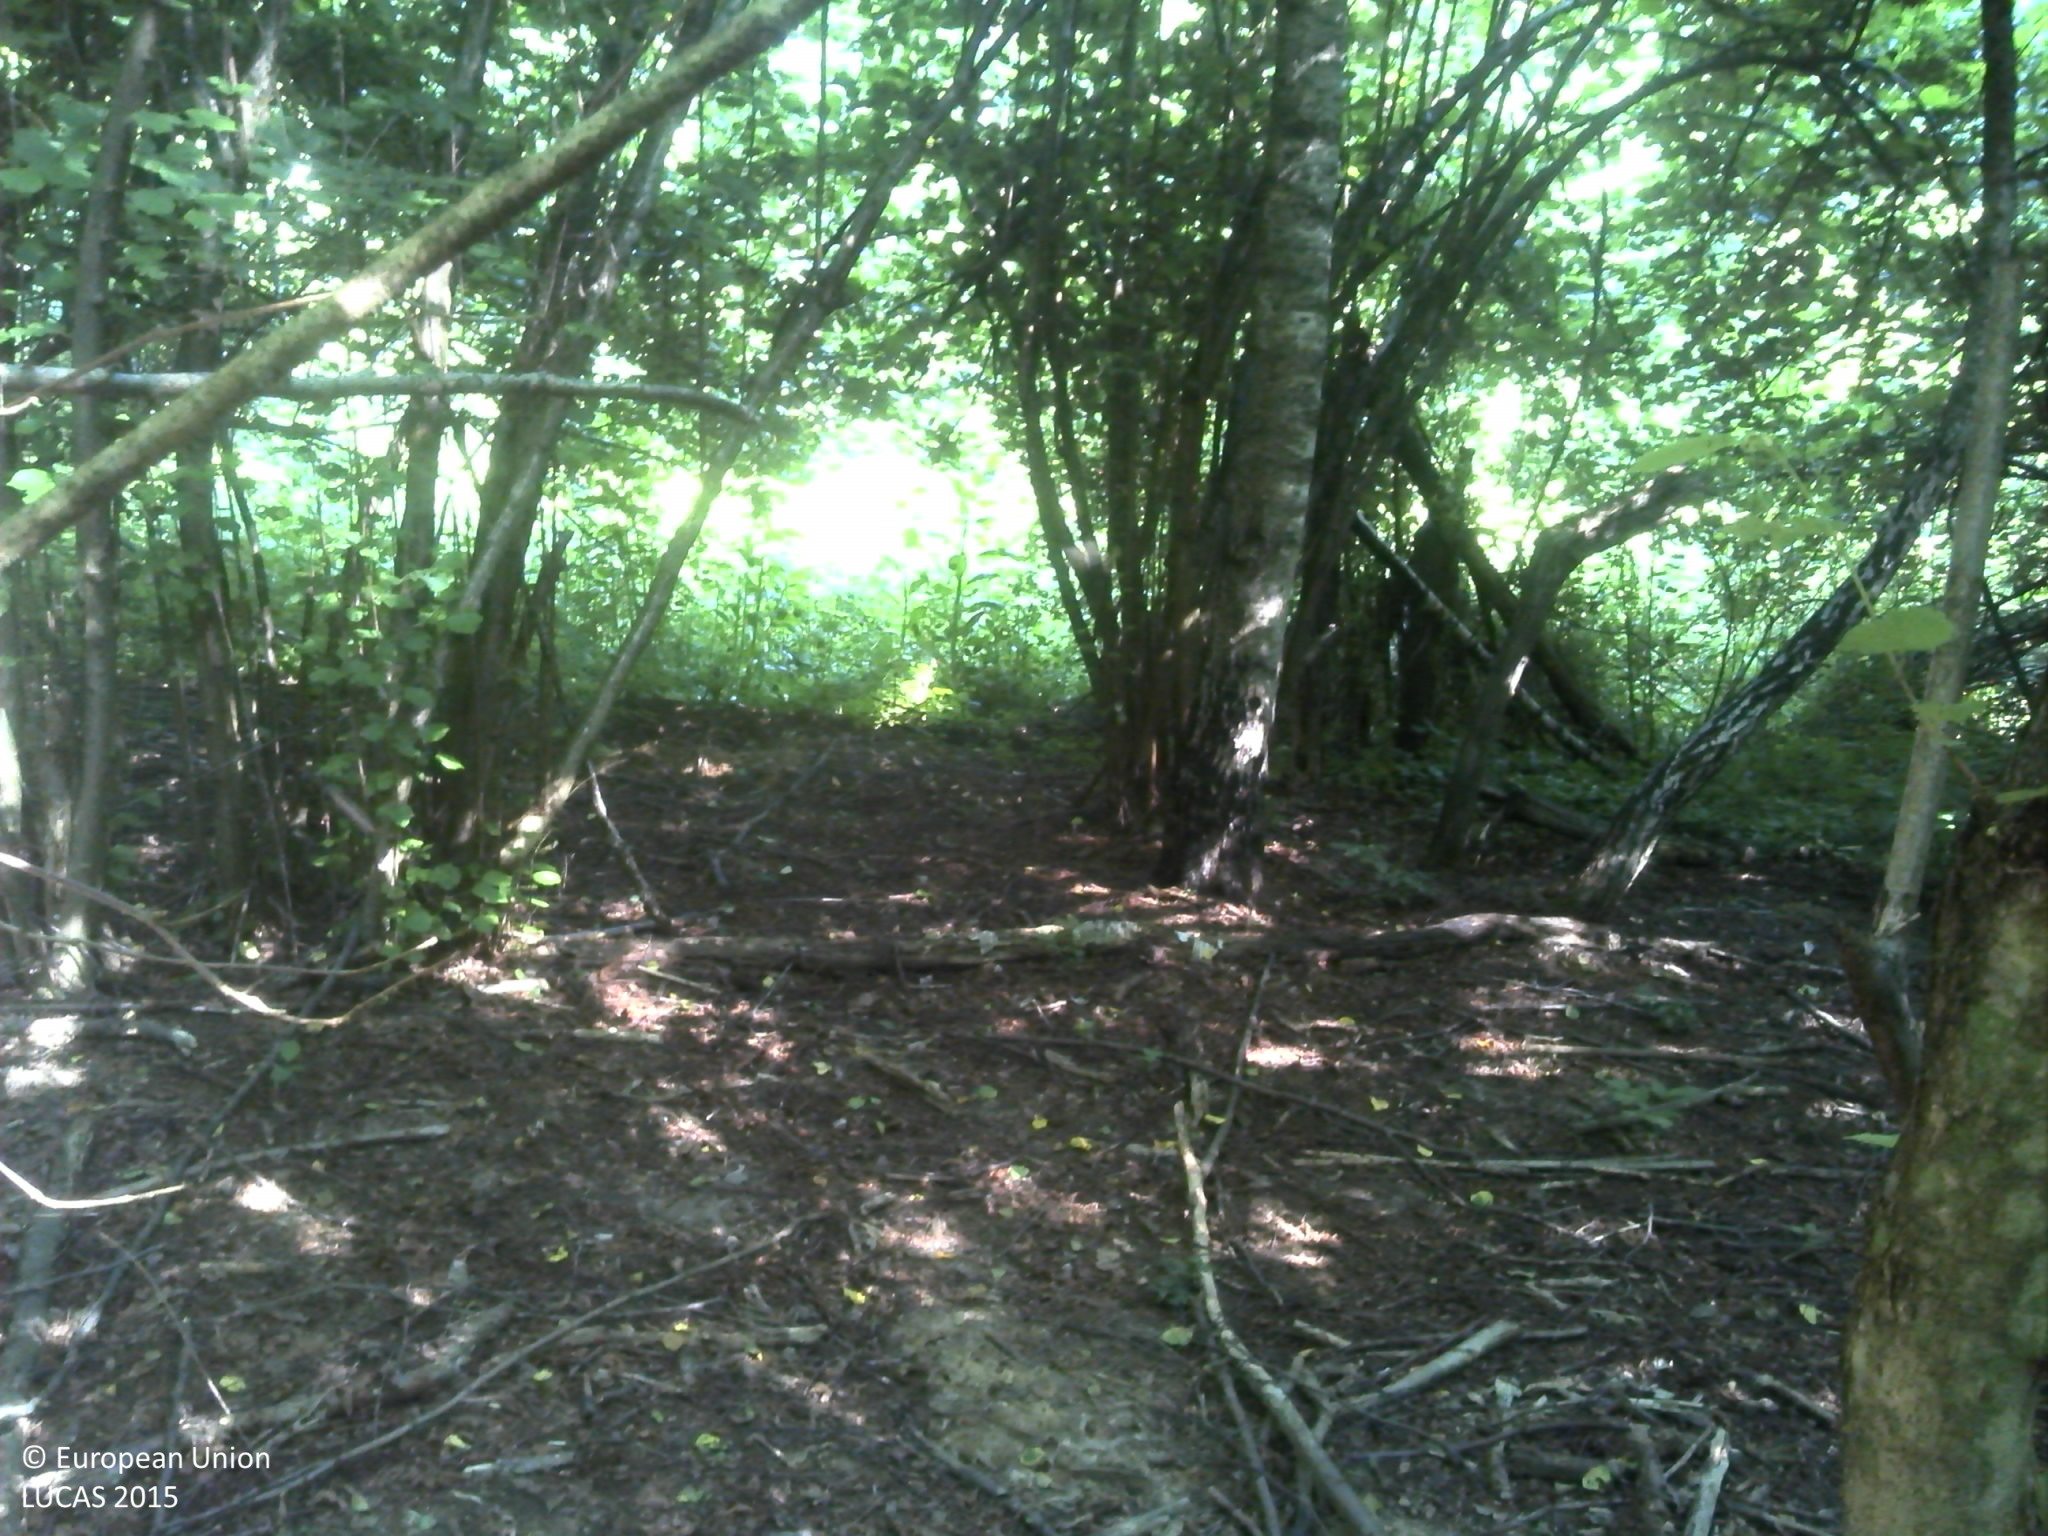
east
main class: Woodland
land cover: Broadleaved woodland
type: acidophilous oak and oak-birch forest
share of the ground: > 75 %
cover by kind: broadleaved forest trees 90 %, shrubs 5 %, herbaceous plants 5 %
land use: Forestry
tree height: > 5 m
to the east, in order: Broadleaved woodland
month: June
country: HR
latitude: 45.5900
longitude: 17.6291
